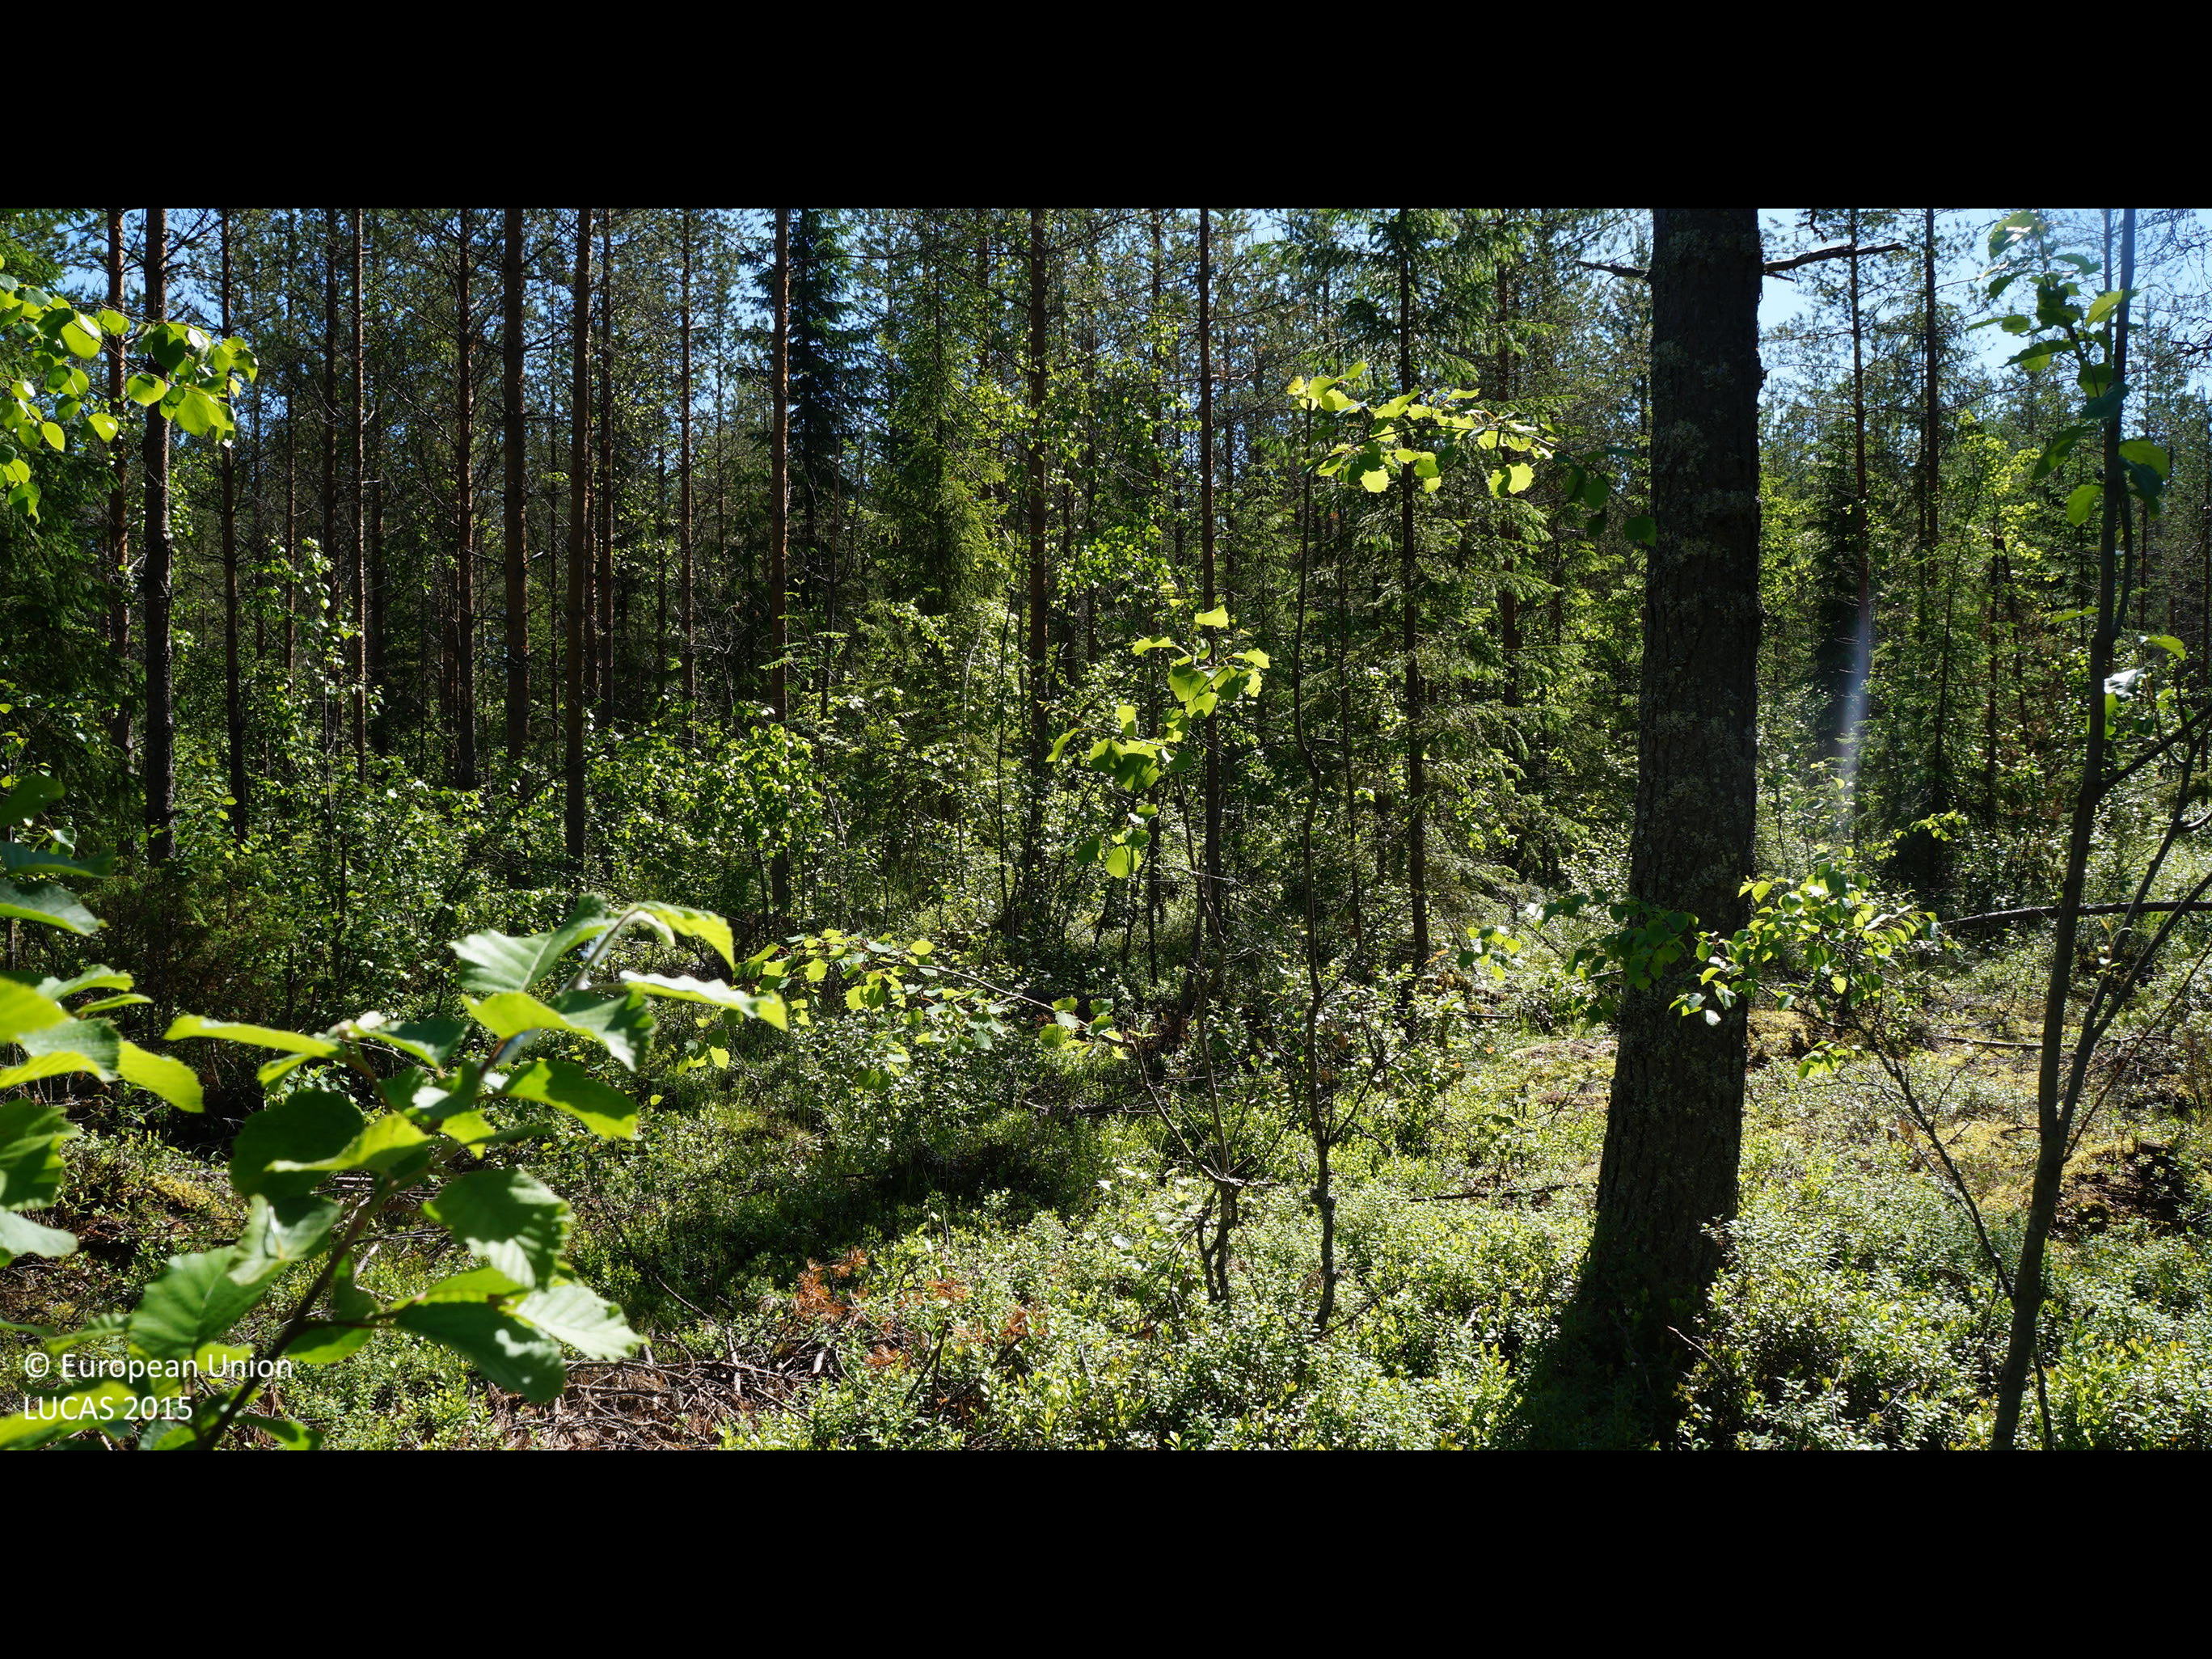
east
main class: Woodland
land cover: Pine dominated coniferous woodland
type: boreal forest
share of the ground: 50 - 75 %
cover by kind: coniferous forest trees 40 %, shrubs 40 %, broadleaved forest trees 10 %, herbaceous plants 5 %, lichens and mosses 5 %
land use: Forestry
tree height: > 5 m
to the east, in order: Pine dominated coniferous woodland; Pine dominated mixed woodland; Tracks; Pine dominated mixed woodland; Pine dominated coniferous woodland; Spruce dominated coniferous woodland; Spruce dominated mixed woodland; Ditches and canals; Shruby margins; Temporary grasslands; Ditches and canals; Temporary grasslands; Ditches and canals; Temporary grasslands; Ditches and canals; Temporary grasslands; Ditches and canals; Temporary grasslands
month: July
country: FI
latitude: 64.1905
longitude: 24.6715
